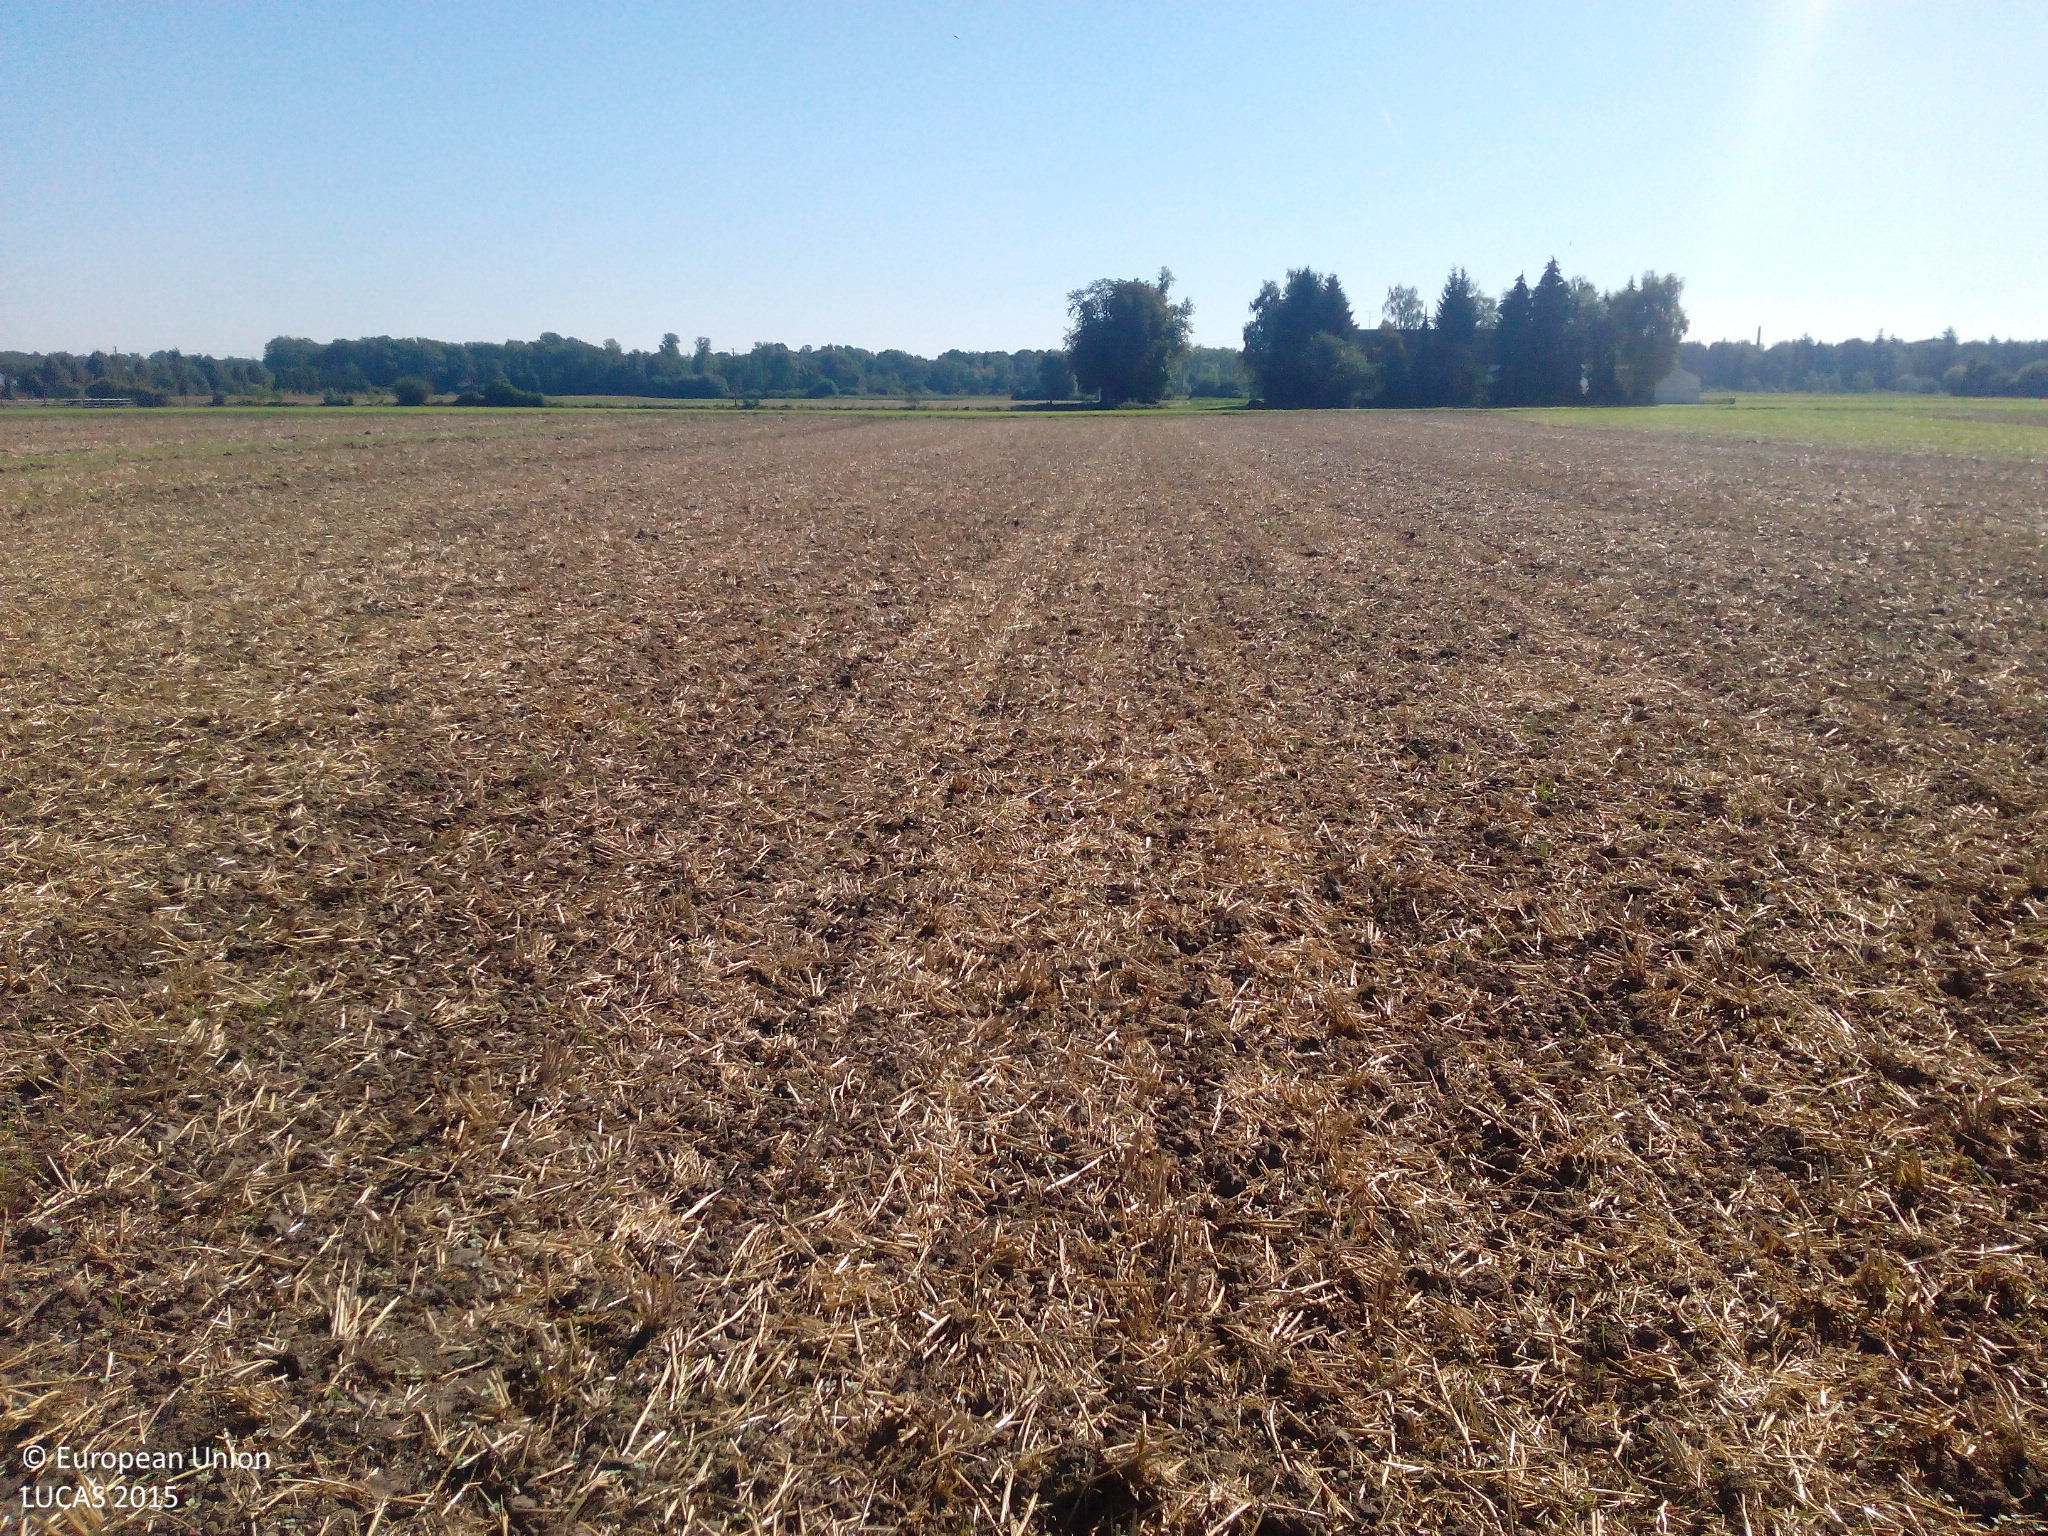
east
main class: Cropland
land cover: Rape and turnip rape
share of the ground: < 10 %
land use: Agriculture (excluding fallow land and kitchen gardens)
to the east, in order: Rape and turnip rape; Tracks; Grass margins; Other leguminous and mixtures for fodder
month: August
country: DE
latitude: 48.7058
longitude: 10.8828
